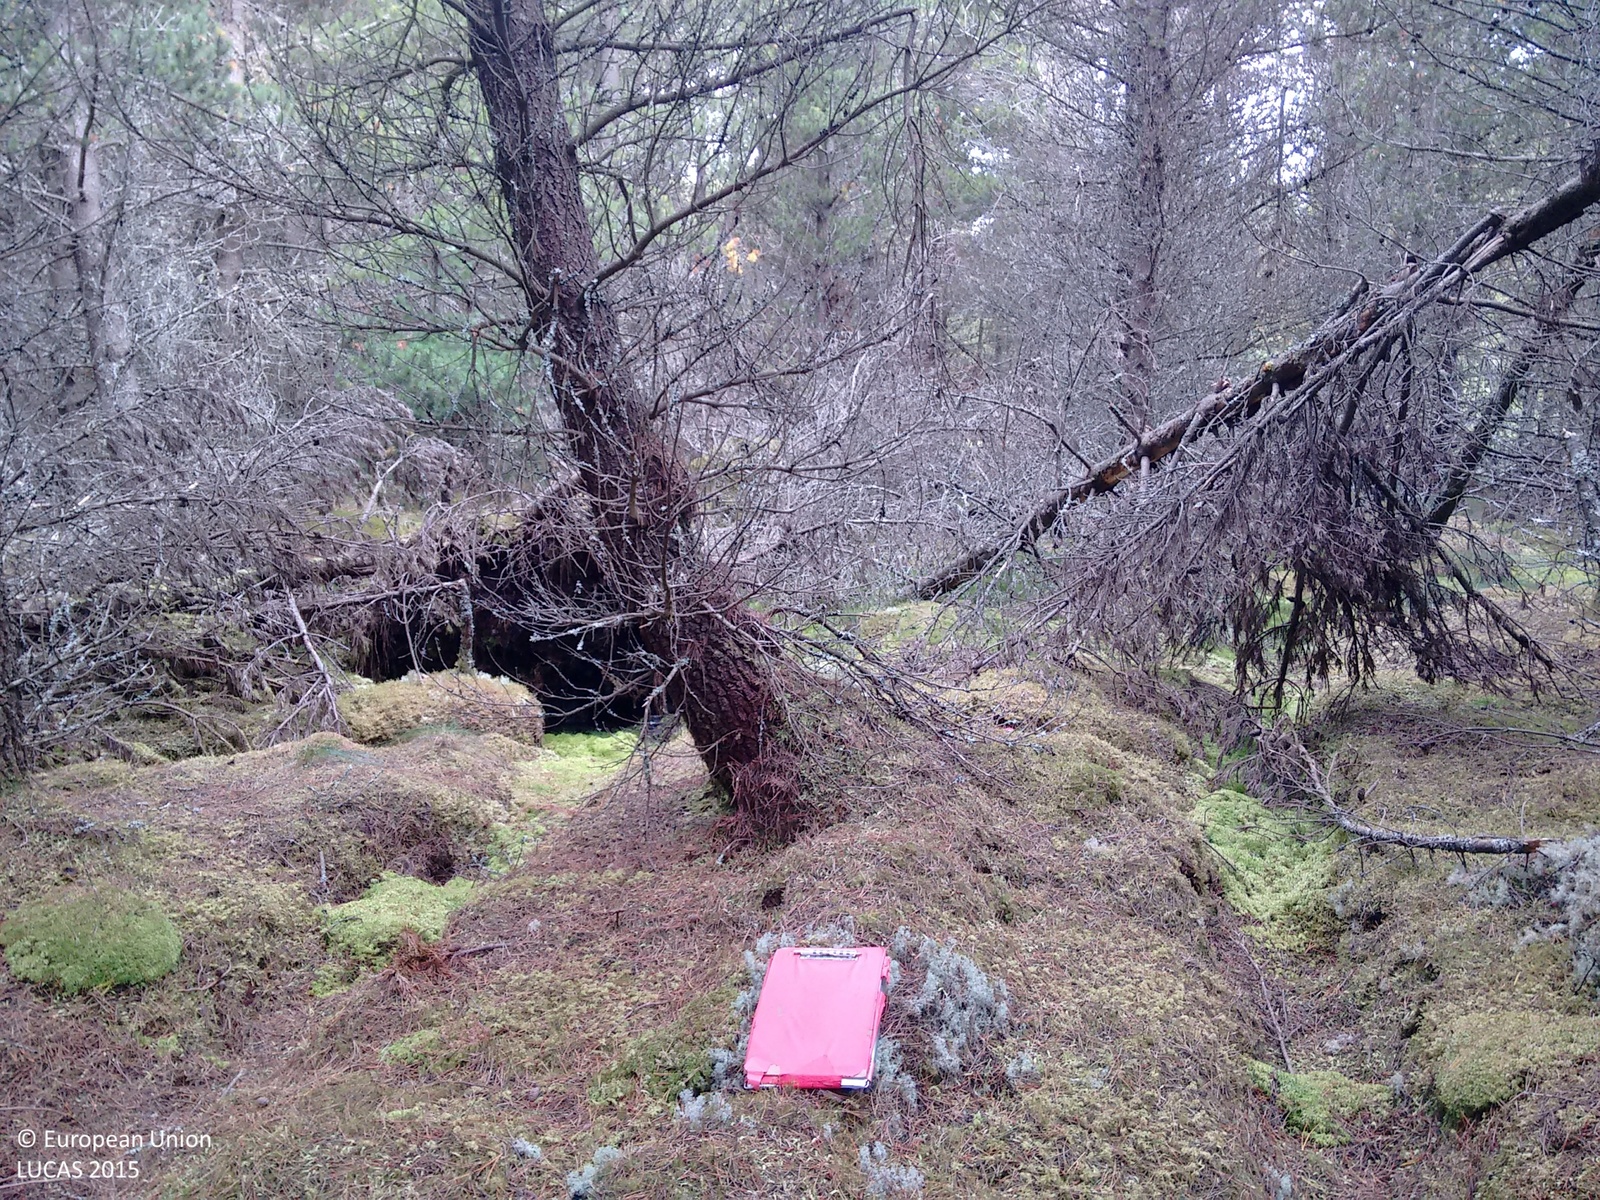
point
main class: Woodland
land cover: Pine dominated coniferous woodland
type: exotic forest
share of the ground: > 75 %
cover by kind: coniferous forest trees 100 %
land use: Forestry
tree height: > 5 m
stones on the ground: < 10 %
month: September
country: GB
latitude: 57.5074
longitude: -3.4043
